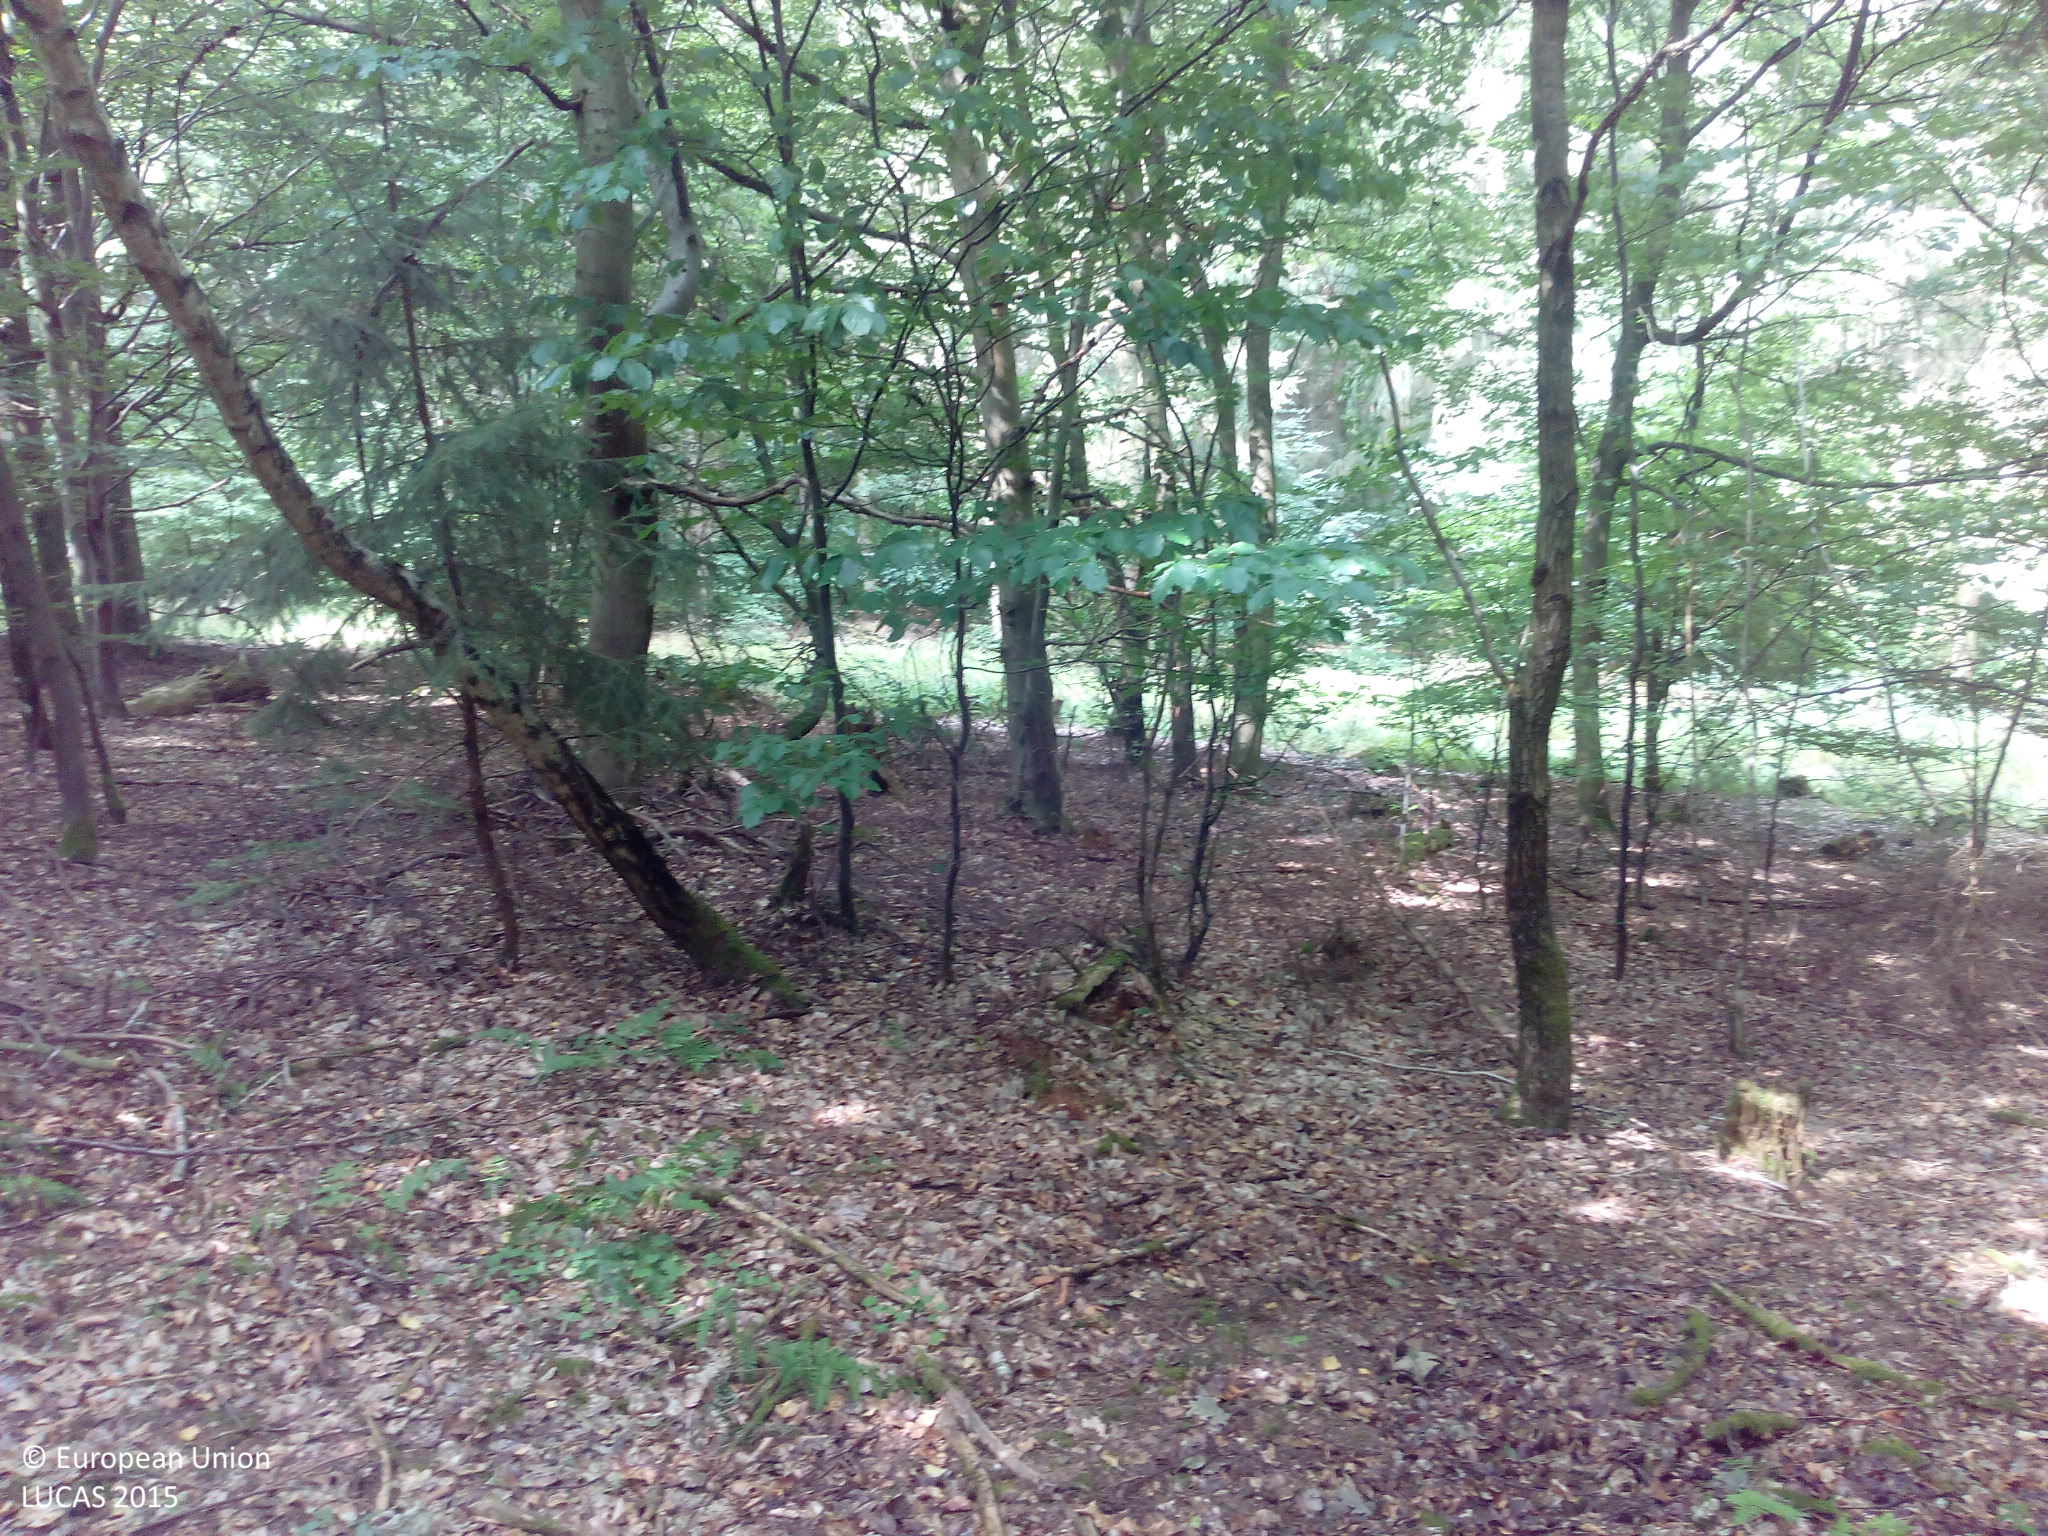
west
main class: Woodland
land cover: Spruce dominated mixed woodland
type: mesophytic deciduous forest
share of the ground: > 75 %
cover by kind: broadleaved forest trees 65 %, coniferous forest trees 25 %, lichens and mosses 5 %, unconsolidated bare surface 5 %
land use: Forestry
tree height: > 5 m
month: August
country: DE
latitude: 49.7254
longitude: 7.5173
